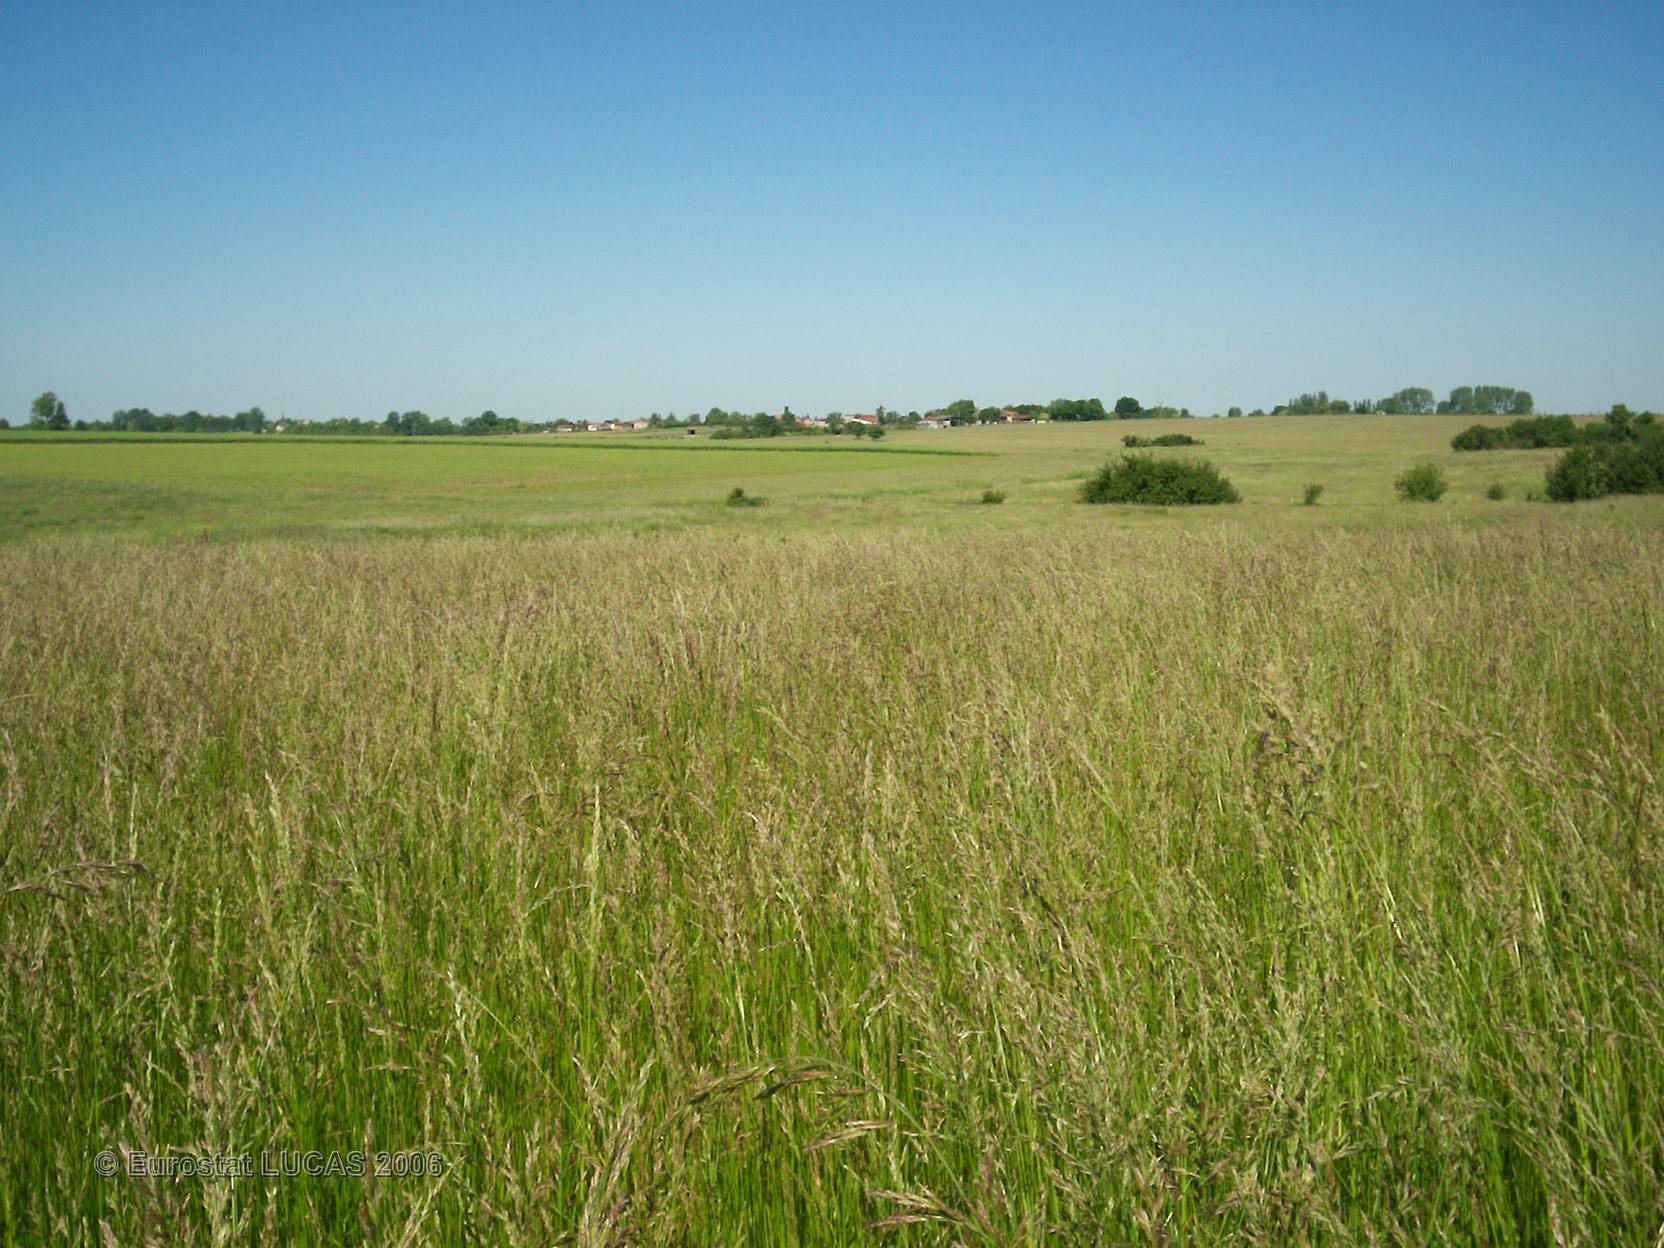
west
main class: Grassland
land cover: Grassland without tree/shrub cover
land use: Agriculture (excluding fallow land and kitchen gardens)
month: June
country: FR
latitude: 48.5802
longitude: 4.6432
